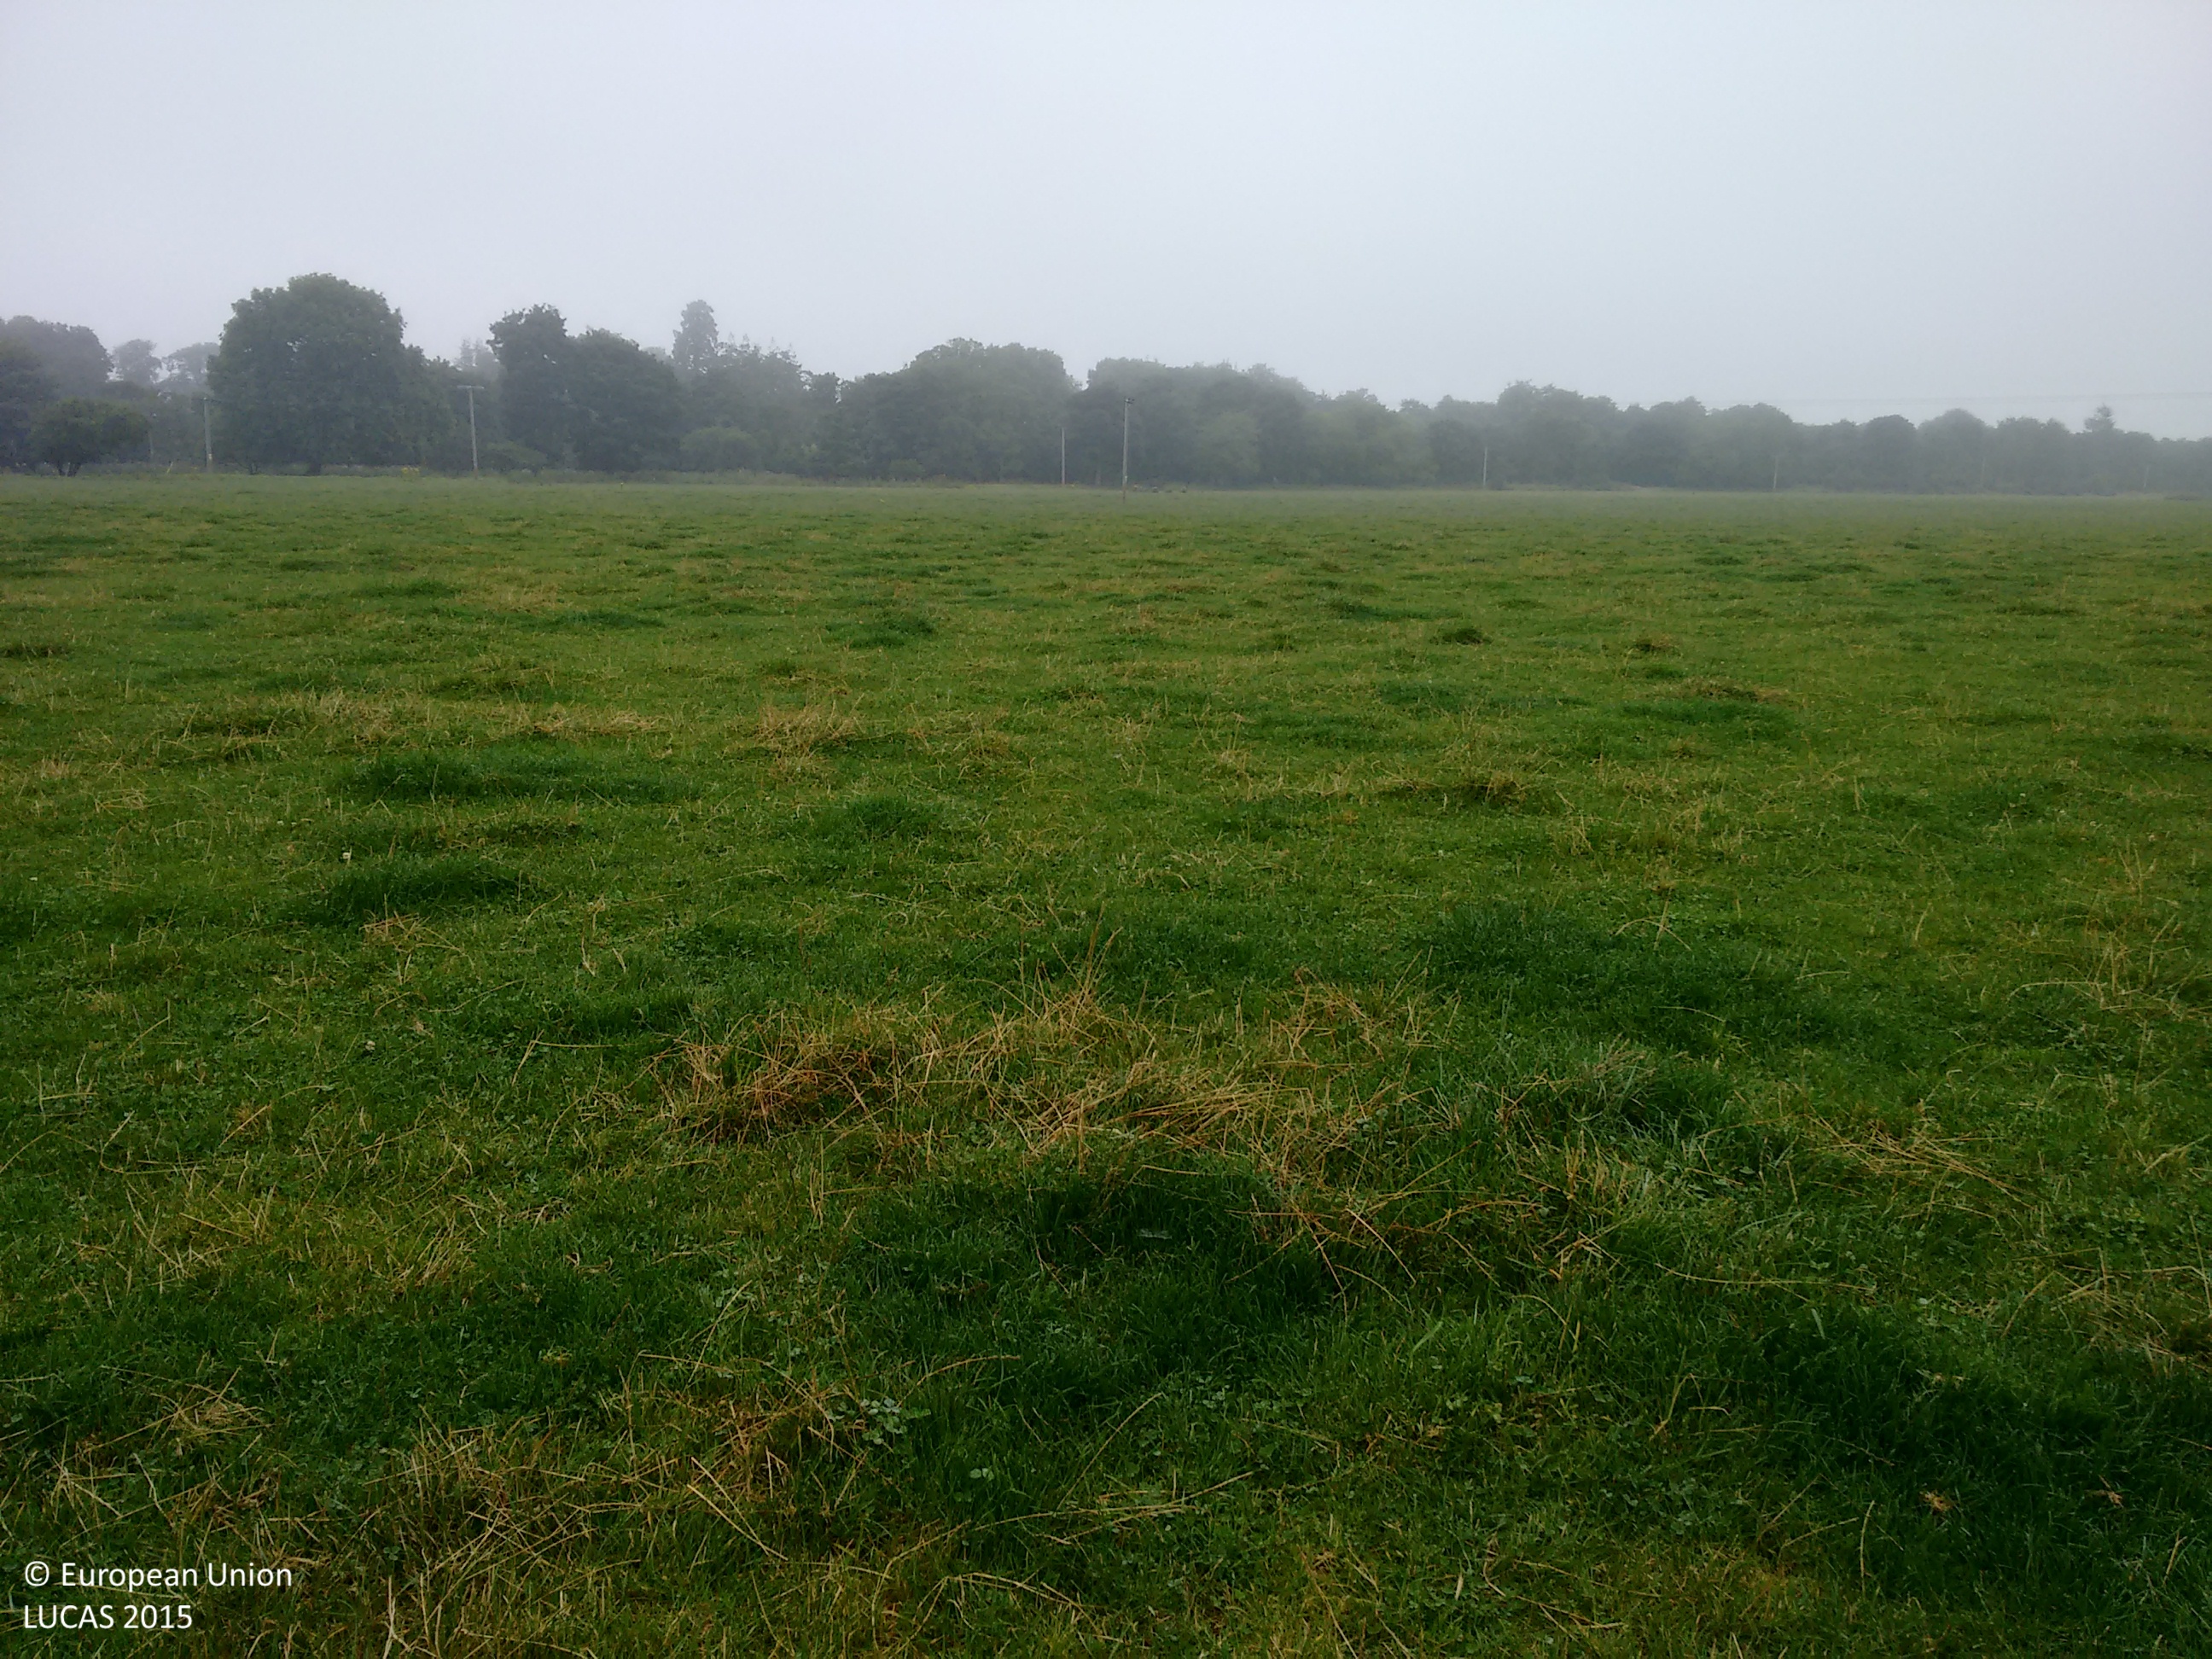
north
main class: Grassland
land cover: Grassland without tree/shrub cover
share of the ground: > 75 %
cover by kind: herbaceous plants 100 %
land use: Agriculture (excluding fallow land and kitchen gardens)
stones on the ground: < 10 %
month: September
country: GB
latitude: 57.5686
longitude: -3.8701
